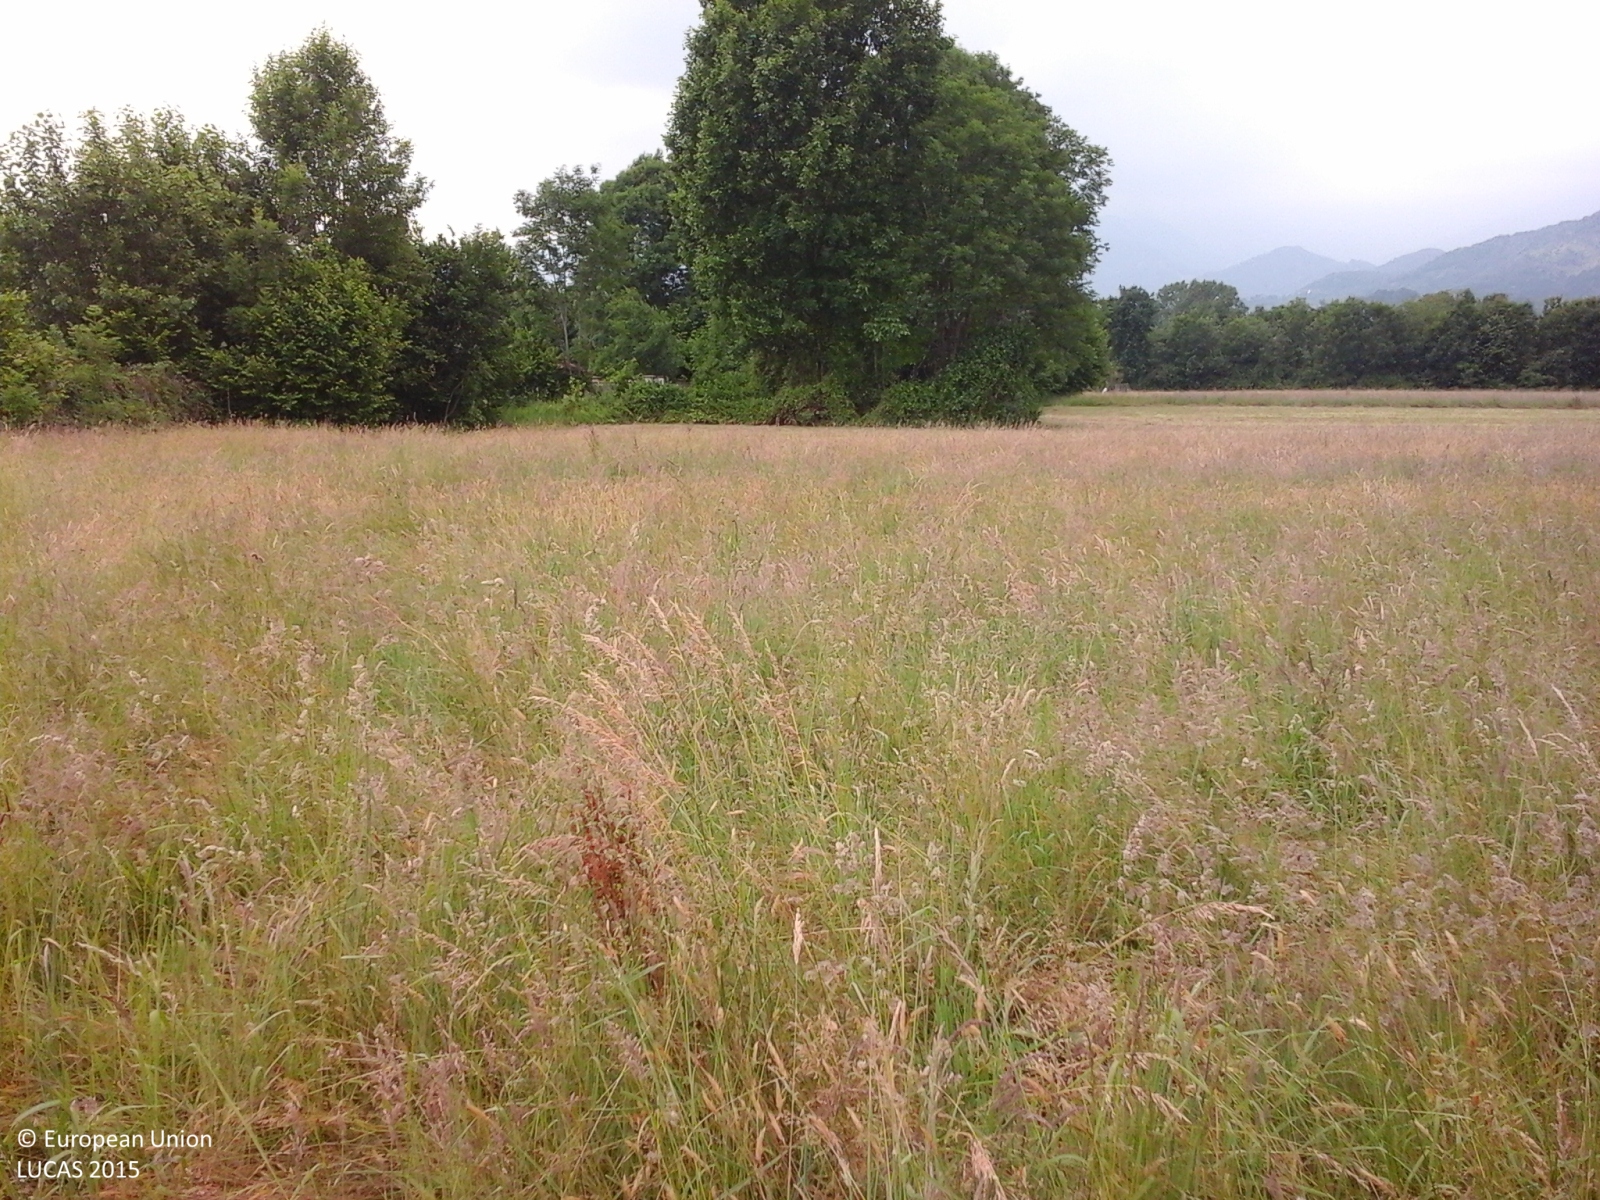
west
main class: Grassland
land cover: Spontaneously vegetated surfaces
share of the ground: > 75 %
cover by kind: herbaceous plants 100 %
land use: Fallow land
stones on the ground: 10 - 25 %
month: May
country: IT
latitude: 45.3525
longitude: 7.6679
